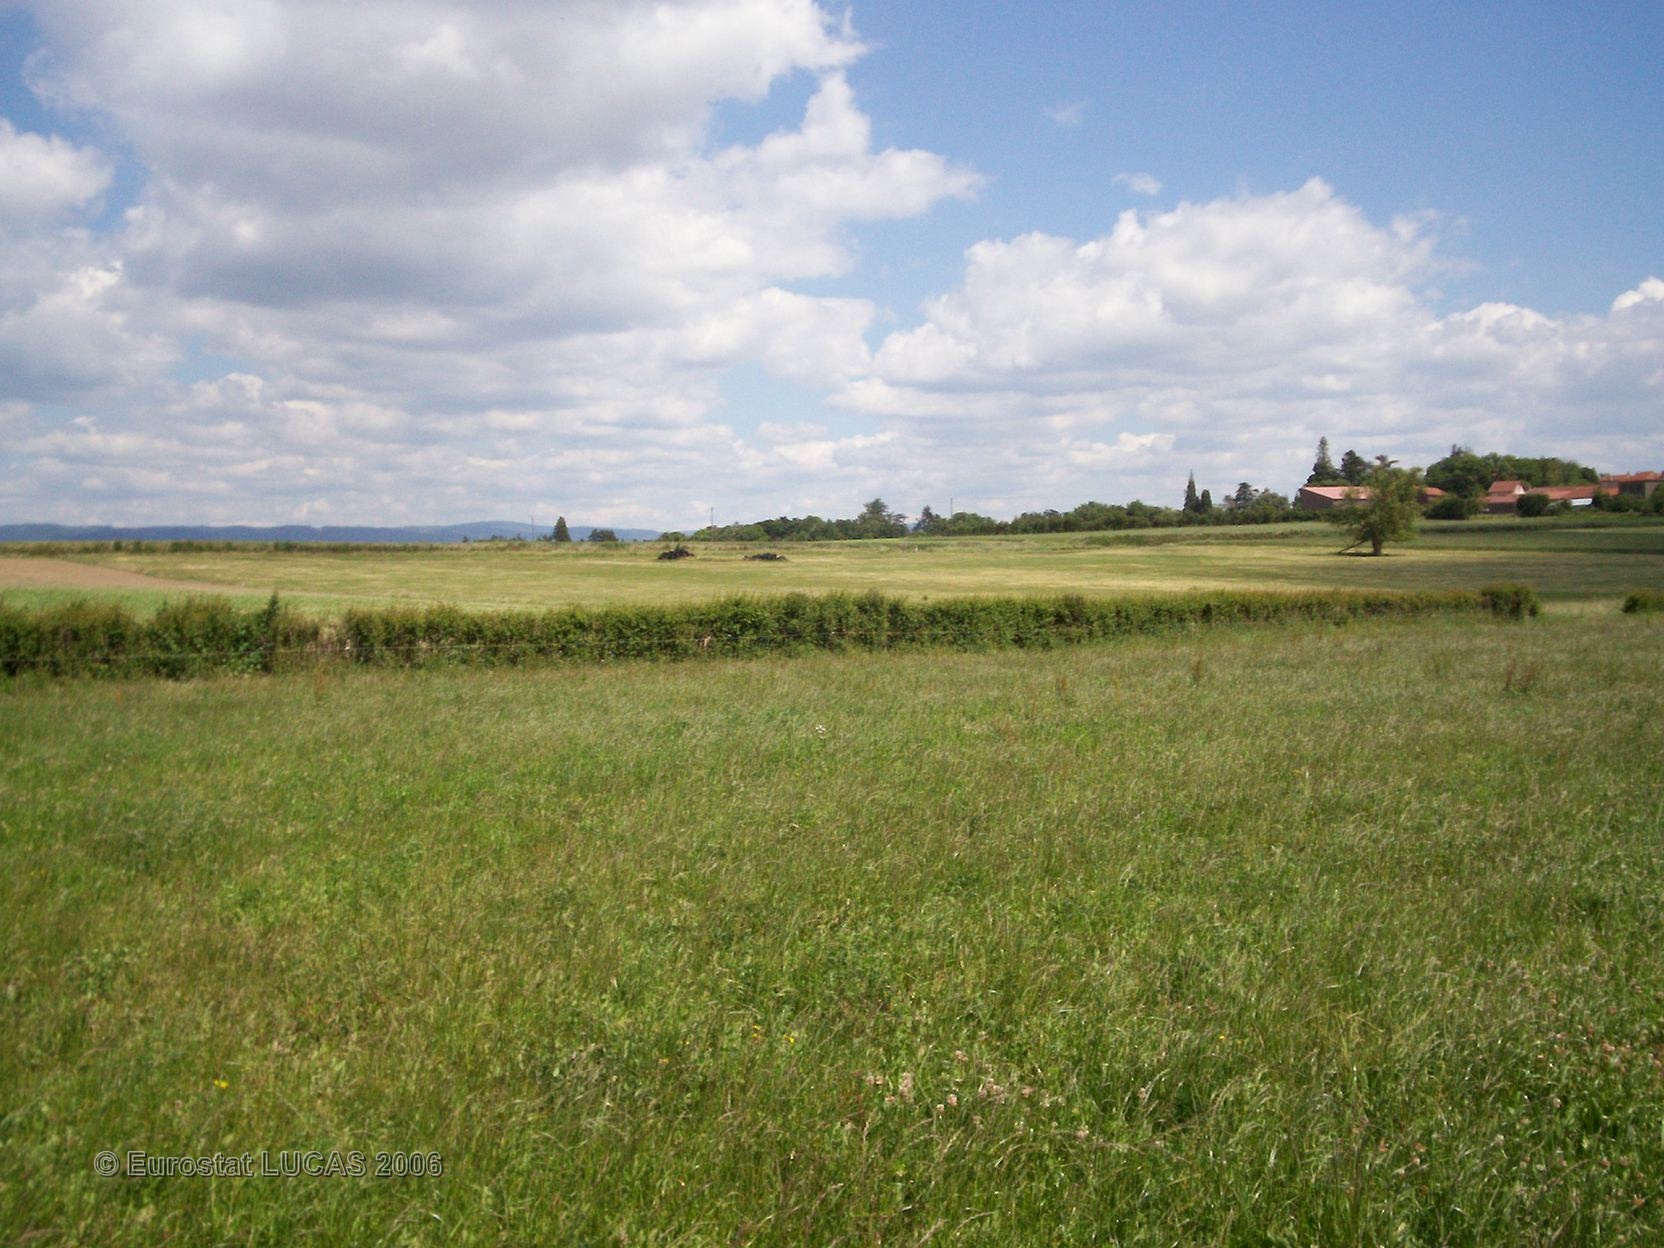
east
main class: Grassland
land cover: Grassland without tree/shrub cover
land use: Agriculture (excluding fallow land and kitchen gardens)
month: June
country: FR
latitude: 45.3474
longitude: 3.3267
